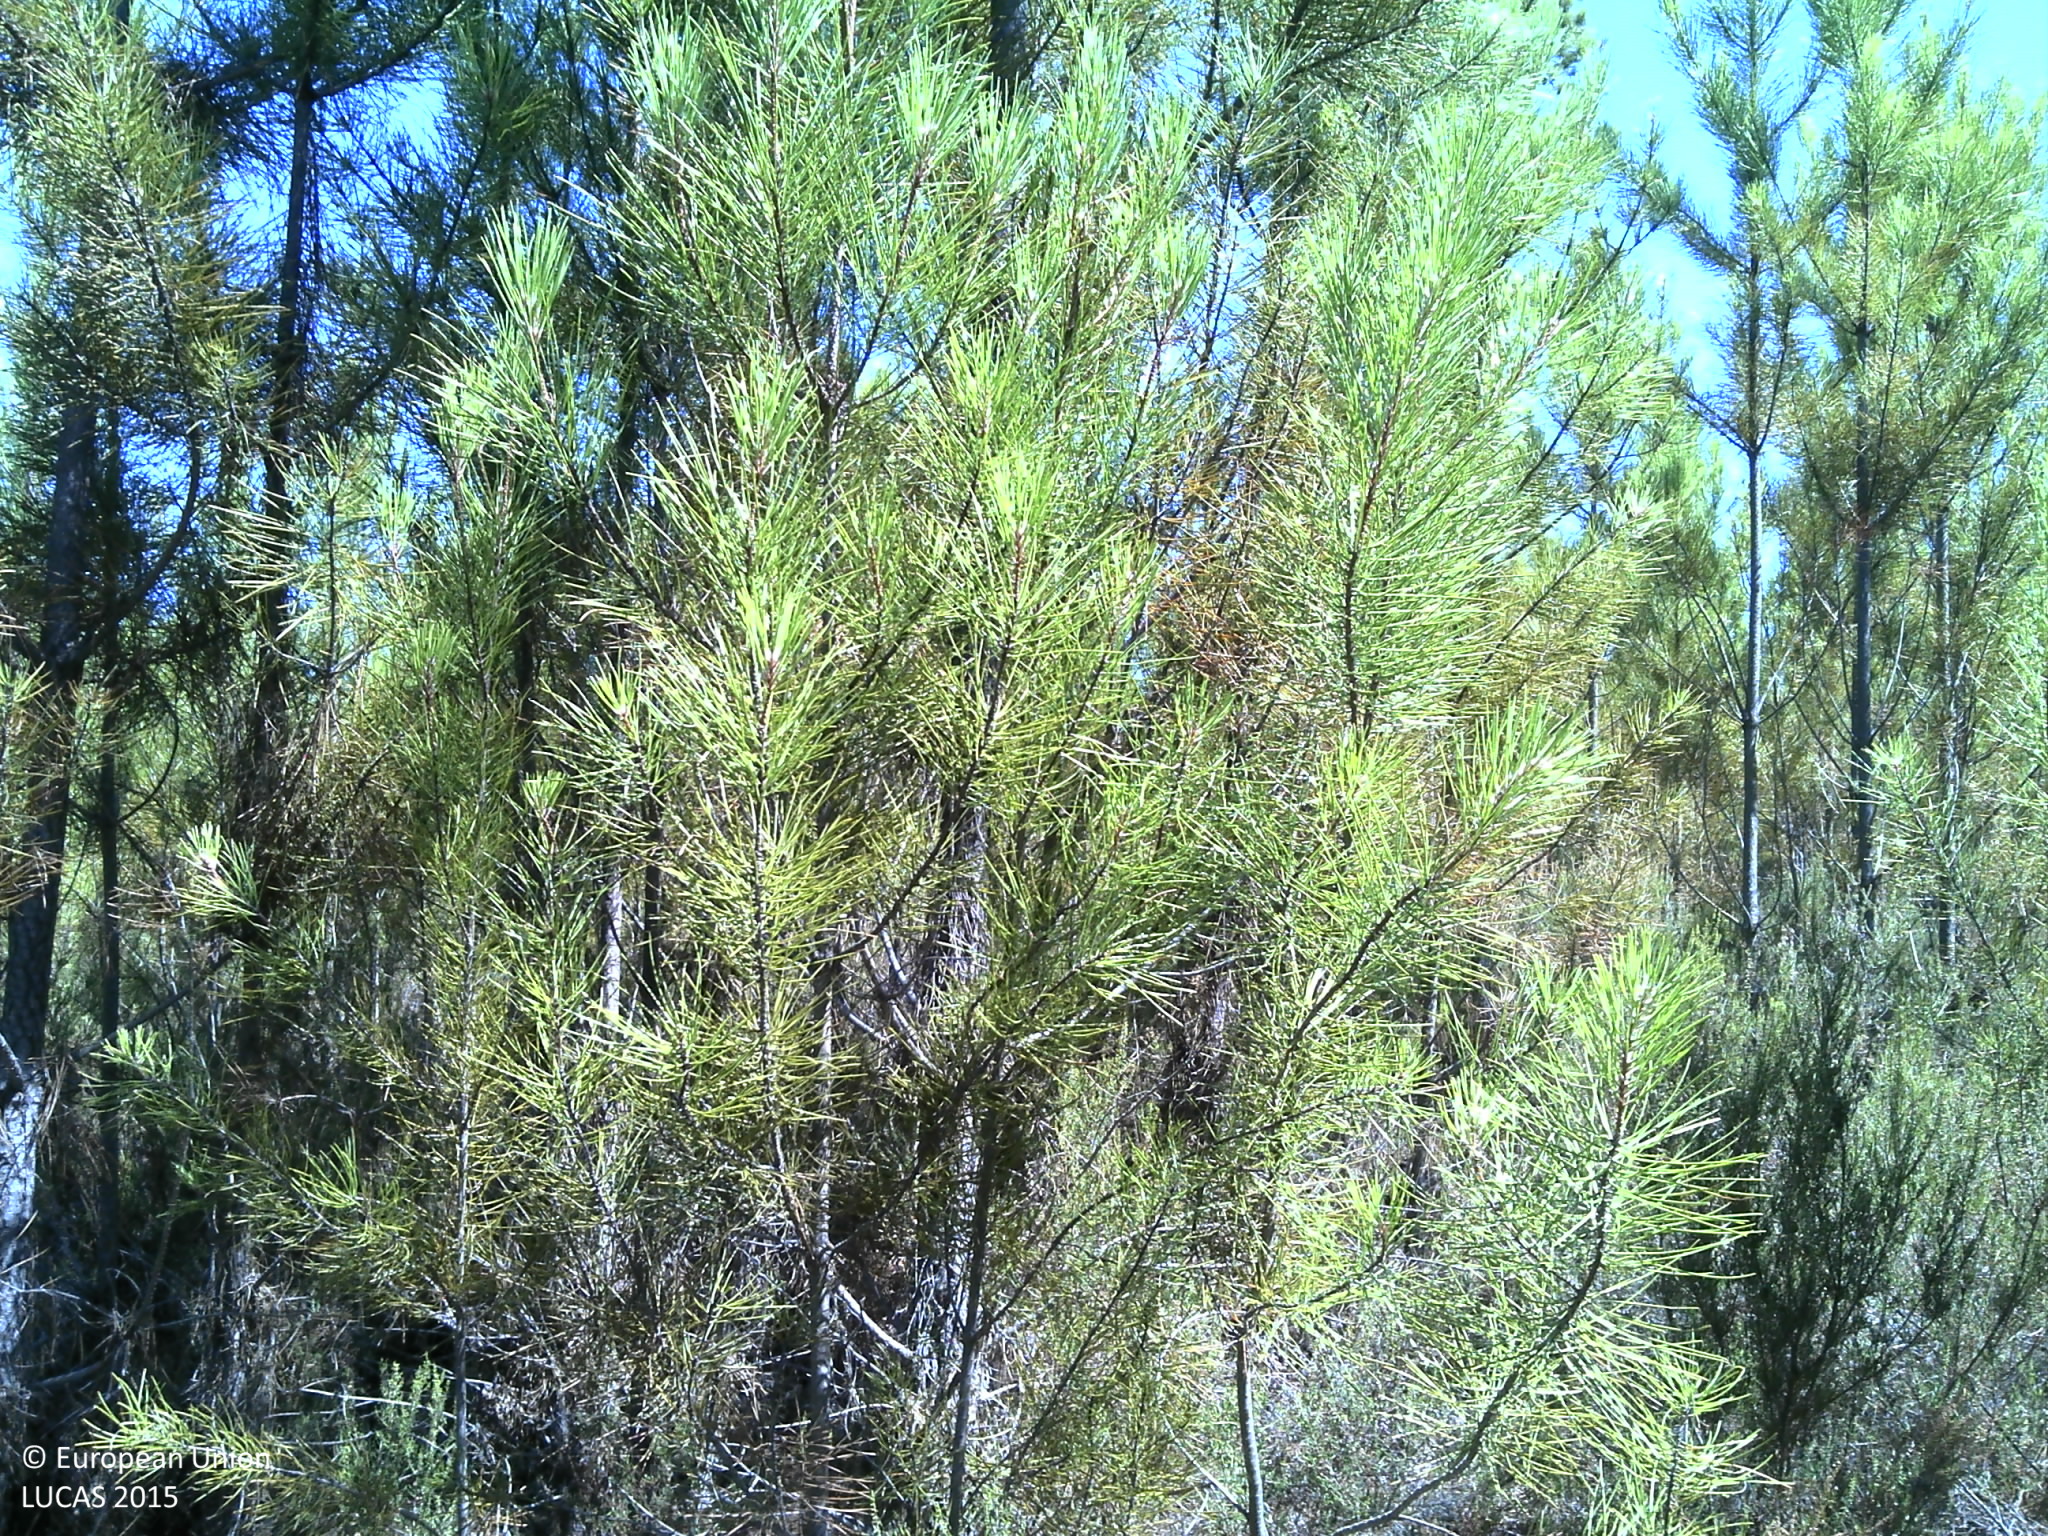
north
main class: Woodland
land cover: Pine dominated coniferous woodland
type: coniferous forest of the mediterranean region
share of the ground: 50 - 75 %
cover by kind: coniferous forest trees 50 %, shrubs 40 %, unconsolidated bare surface 10 %
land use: Forestry
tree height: < 5 m
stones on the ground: > 50 %
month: July
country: PT
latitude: 39.7848
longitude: -7.8200
